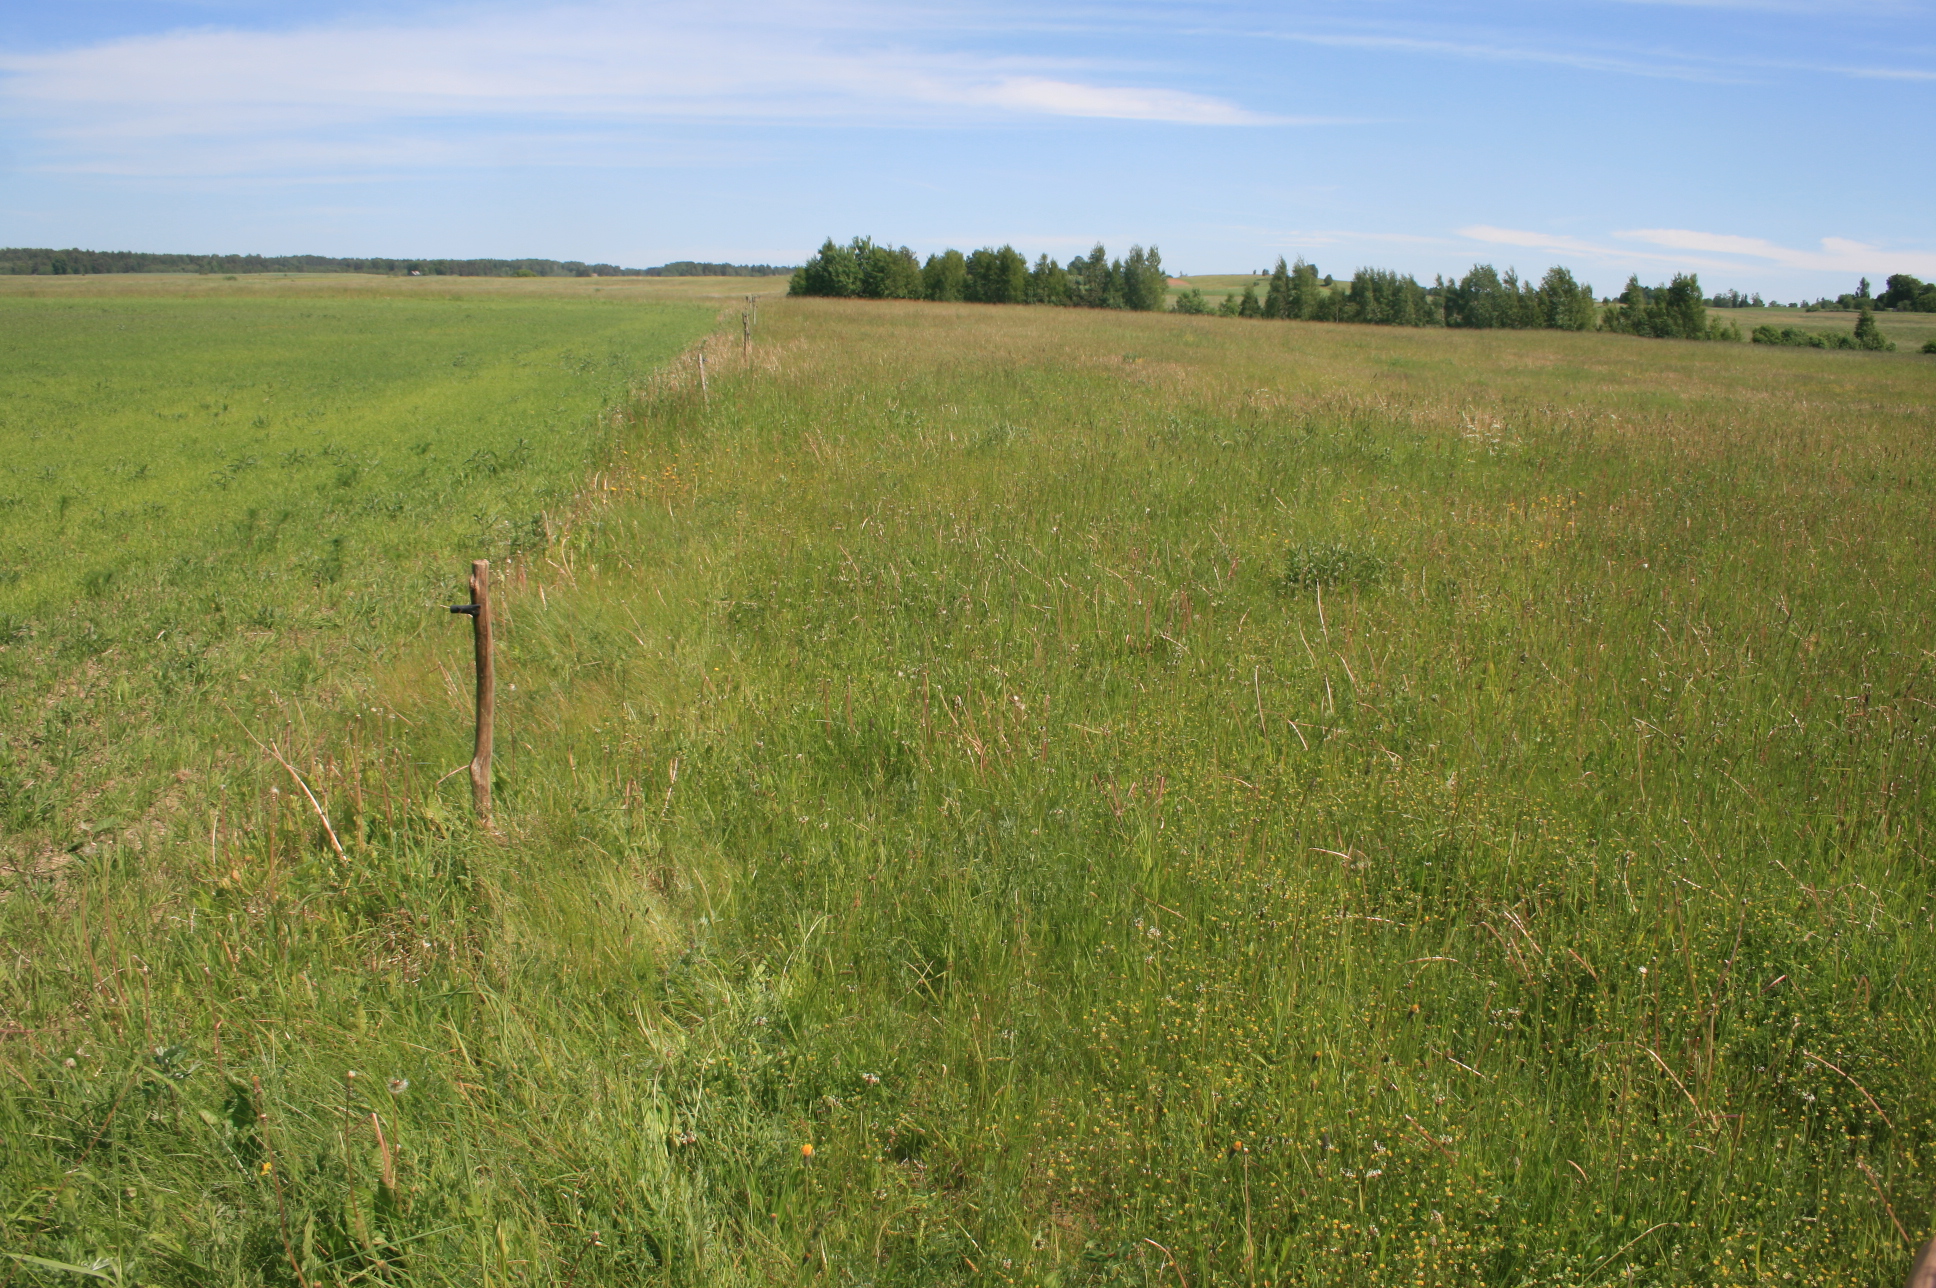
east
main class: Grassland
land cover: Grassland without tree/shrub cover
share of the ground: > 75 %
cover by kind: herbaceous plants 100 %
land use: Agriculture (excluding fallow land and kitchen gardens)
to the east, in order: Grassland without tree/shrub cover; Abandoned hedges; Grassland without tree/shrub cover
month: June
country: LT
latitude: 55.9297
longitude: 22.3982
